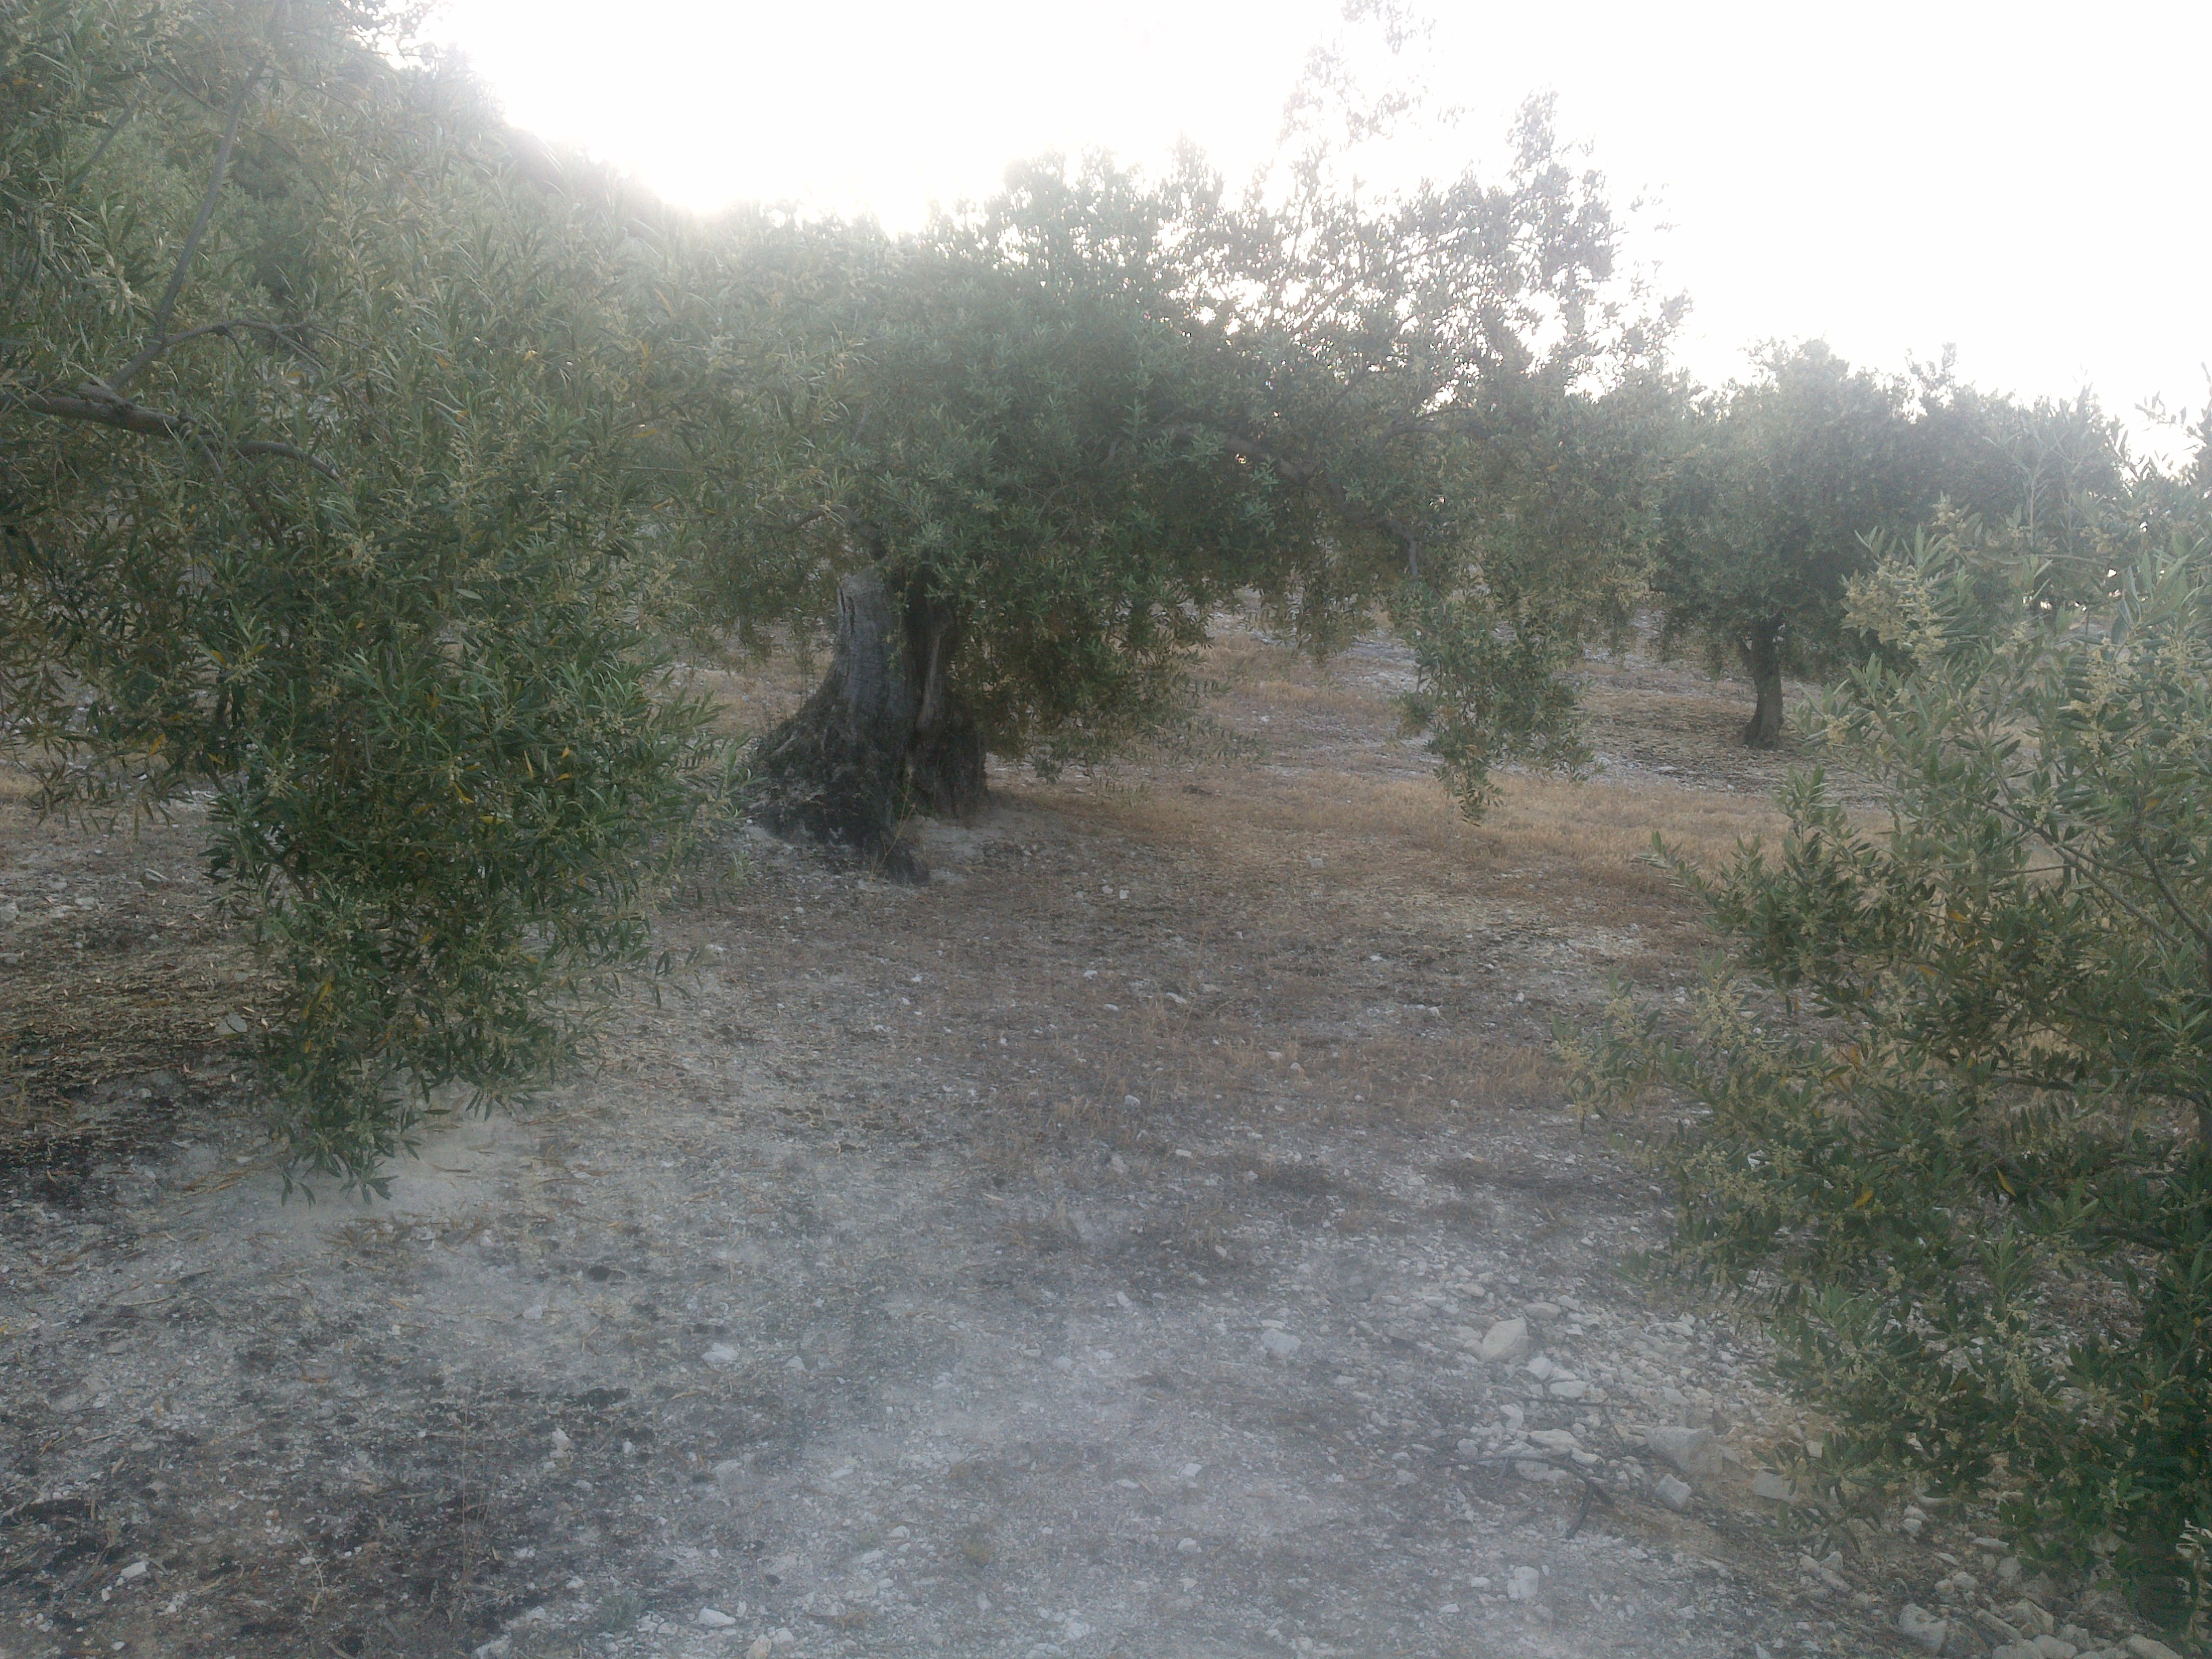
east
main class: Cropland
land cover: Olive groves
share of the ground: 50 - 75 %
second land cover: Spontaneously vegetated surfaces
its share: 10 - 25 %
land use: Agriculture (excluding fallow land and kitchen gardens)
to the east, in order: Olive groves; Spontaneously vegetated surfaces; Tracks; Shrubland with sparse tree cover; Shrubland without tree cover
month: May
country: ES
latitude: 37.4433
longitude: -4.2306
